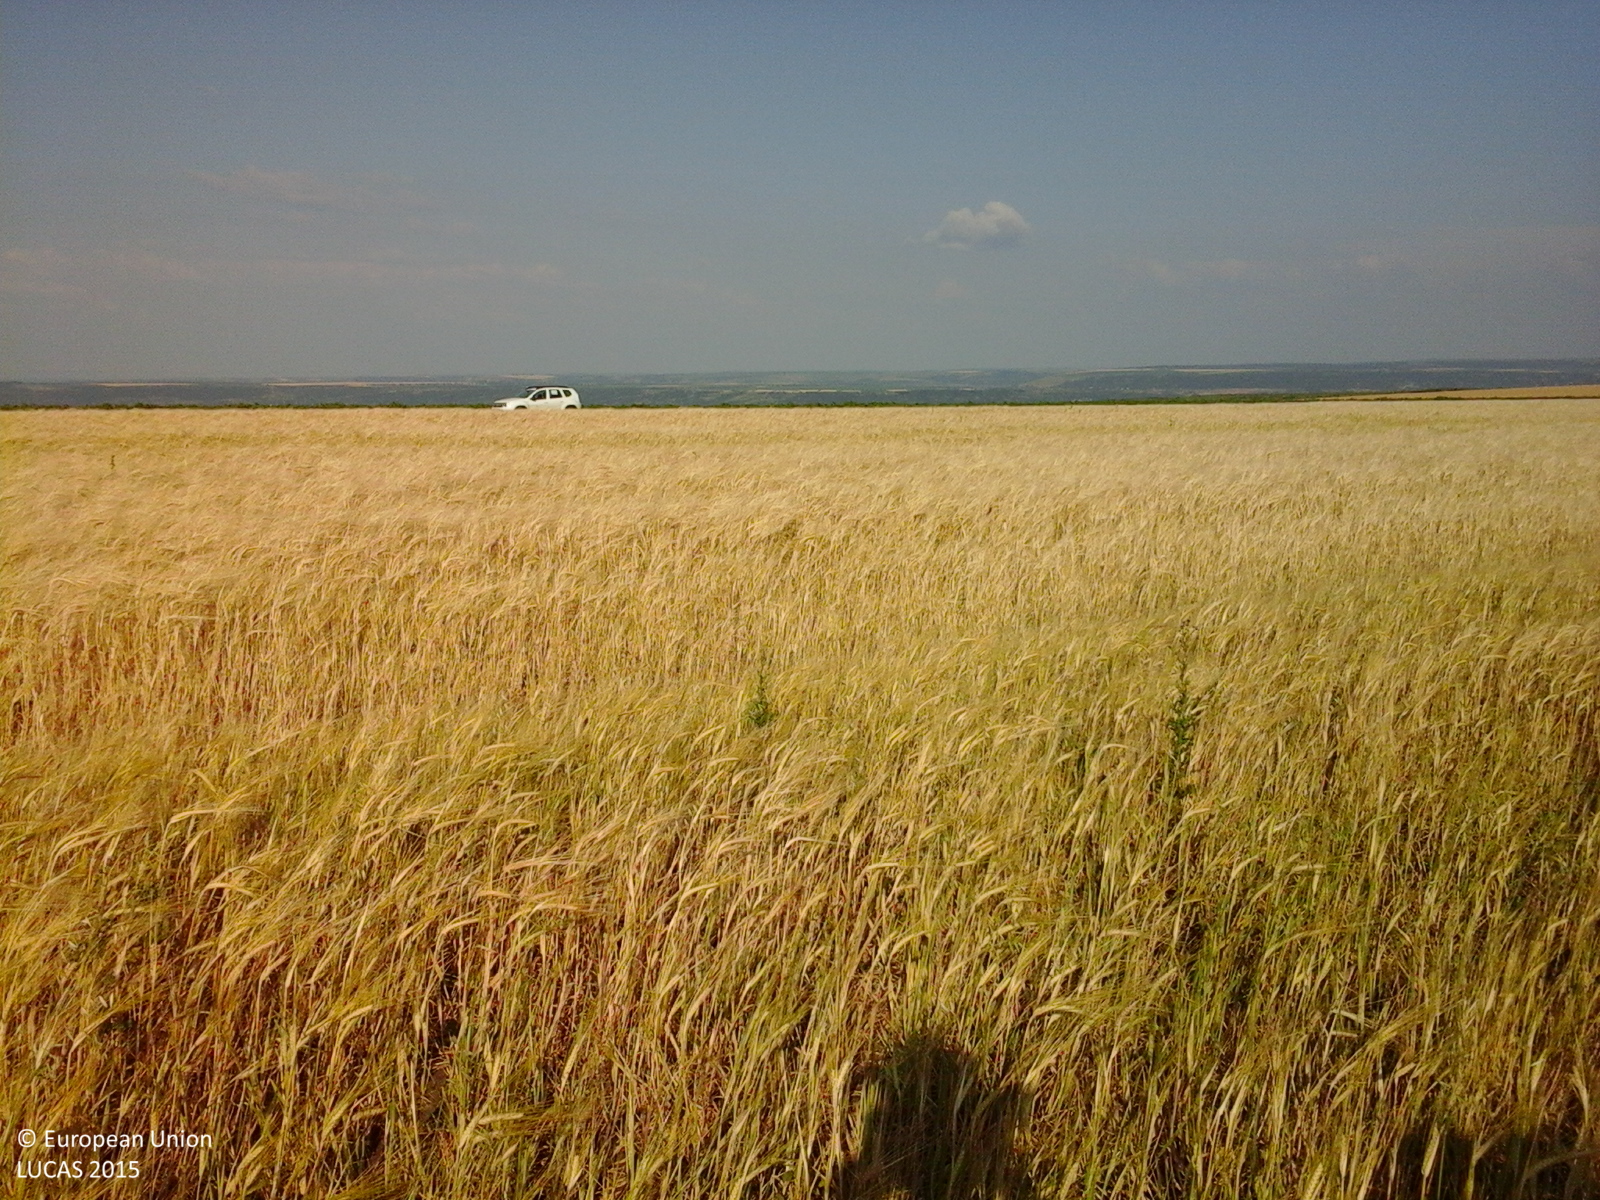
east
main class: Cropland
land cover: Barley
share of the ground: > 75 %
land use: Agriculture (excluding fallow land and kitchen gardens)
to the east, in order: Barley; Grass margins; Tracks; Grass margins; Sunflower
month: June
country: RO
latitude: 46.8011
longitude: 28.0958
